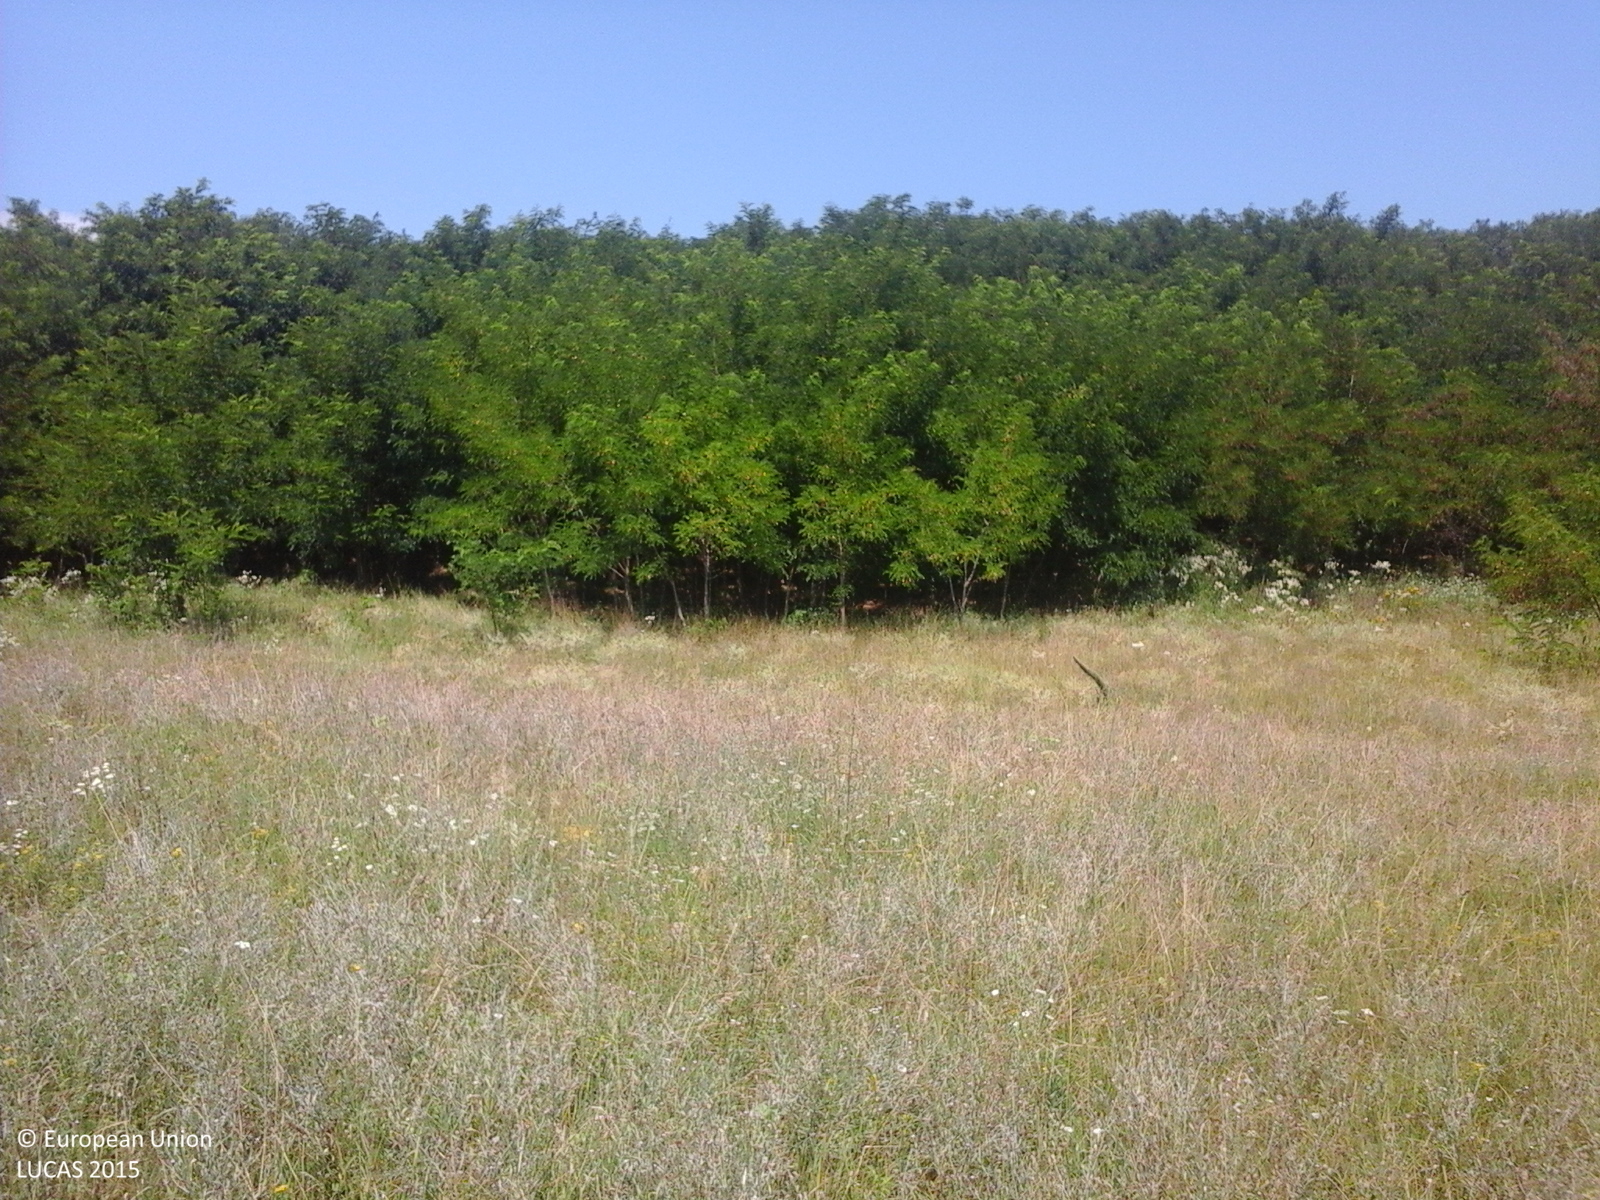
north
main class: Grassland
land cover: Grassland without tree/shrub cover
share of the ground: > 75 %
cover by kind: herbaceous plants 100 %
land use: Agriculture (excluding fallow land and kitchen gardens)
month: July
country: RO
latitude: 44.2038
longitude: 24.2417
